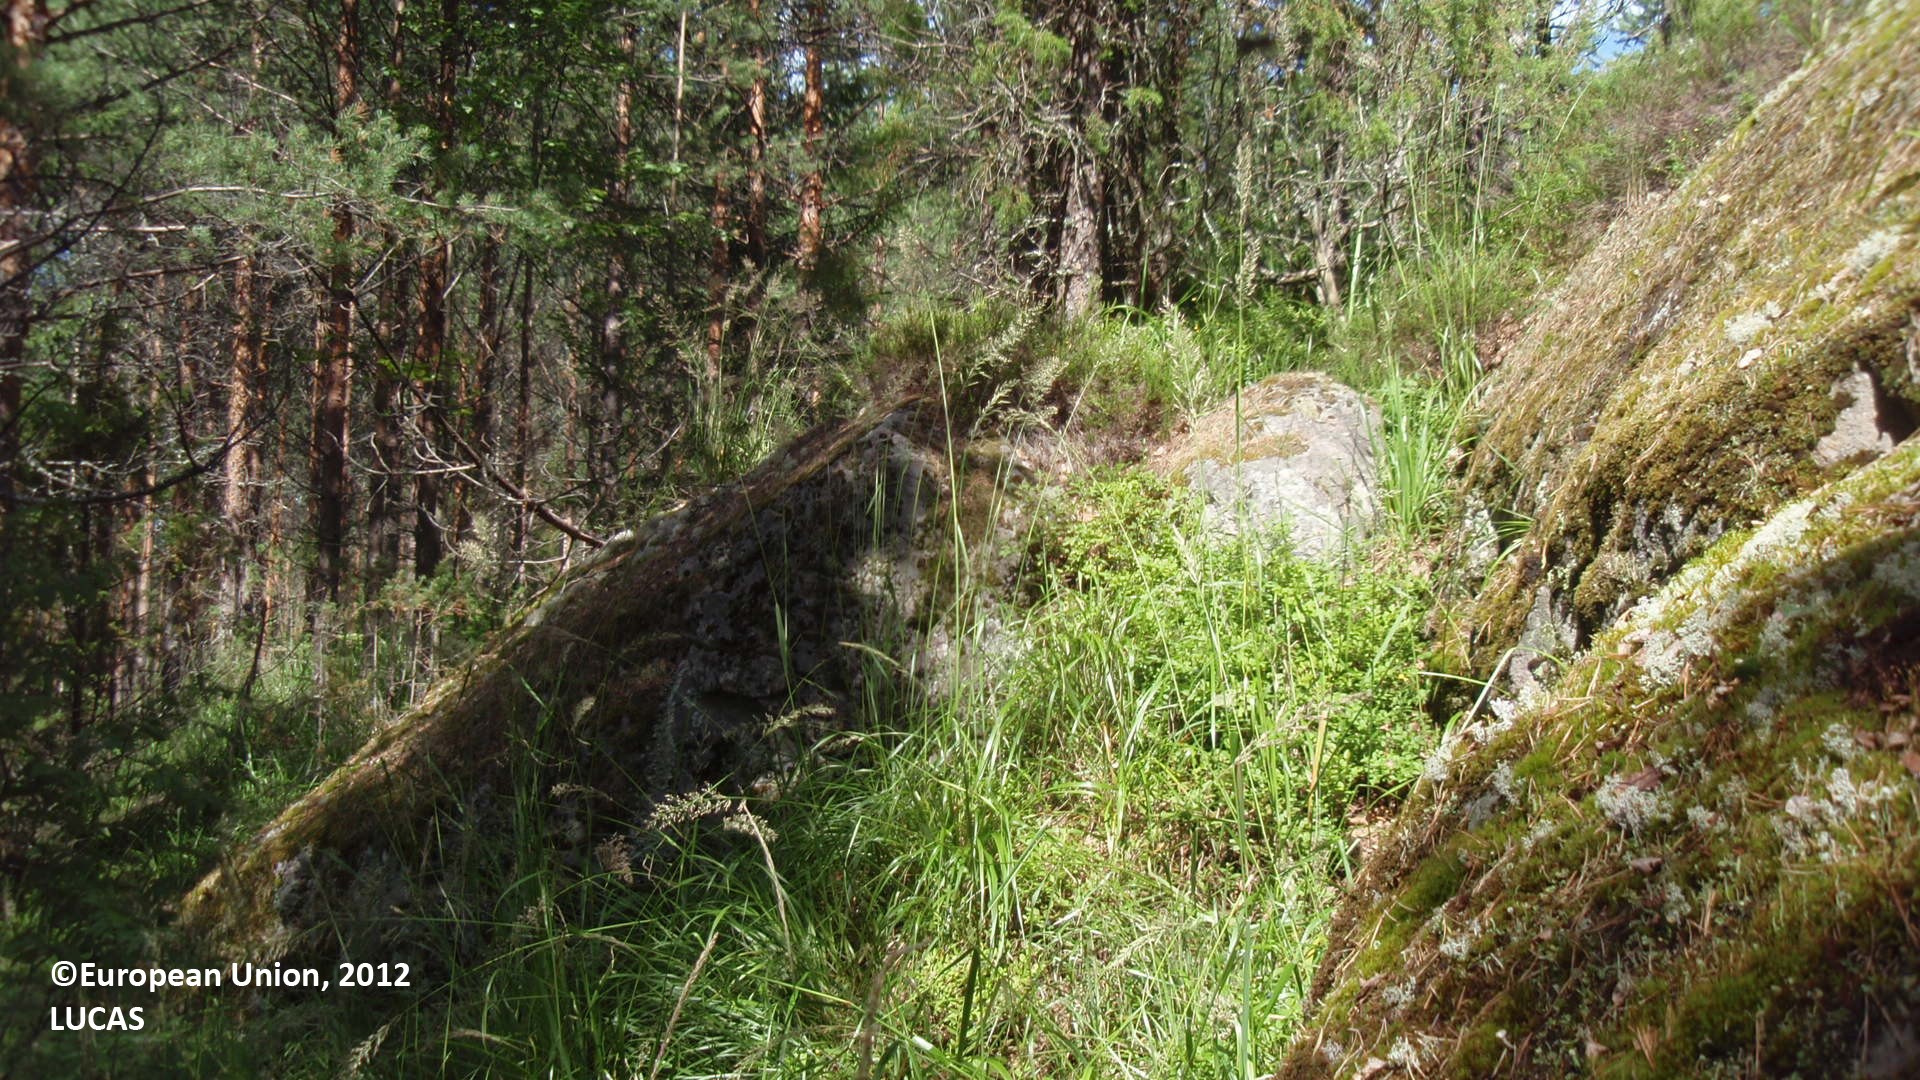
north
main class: Woodland
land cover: Pine dominated coniferous woodland
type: boreal forest
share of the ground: 50 - 75 %
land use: Forestry
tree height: > 5 m
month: July
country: FI
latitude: 61.5791
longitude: 28.4994
